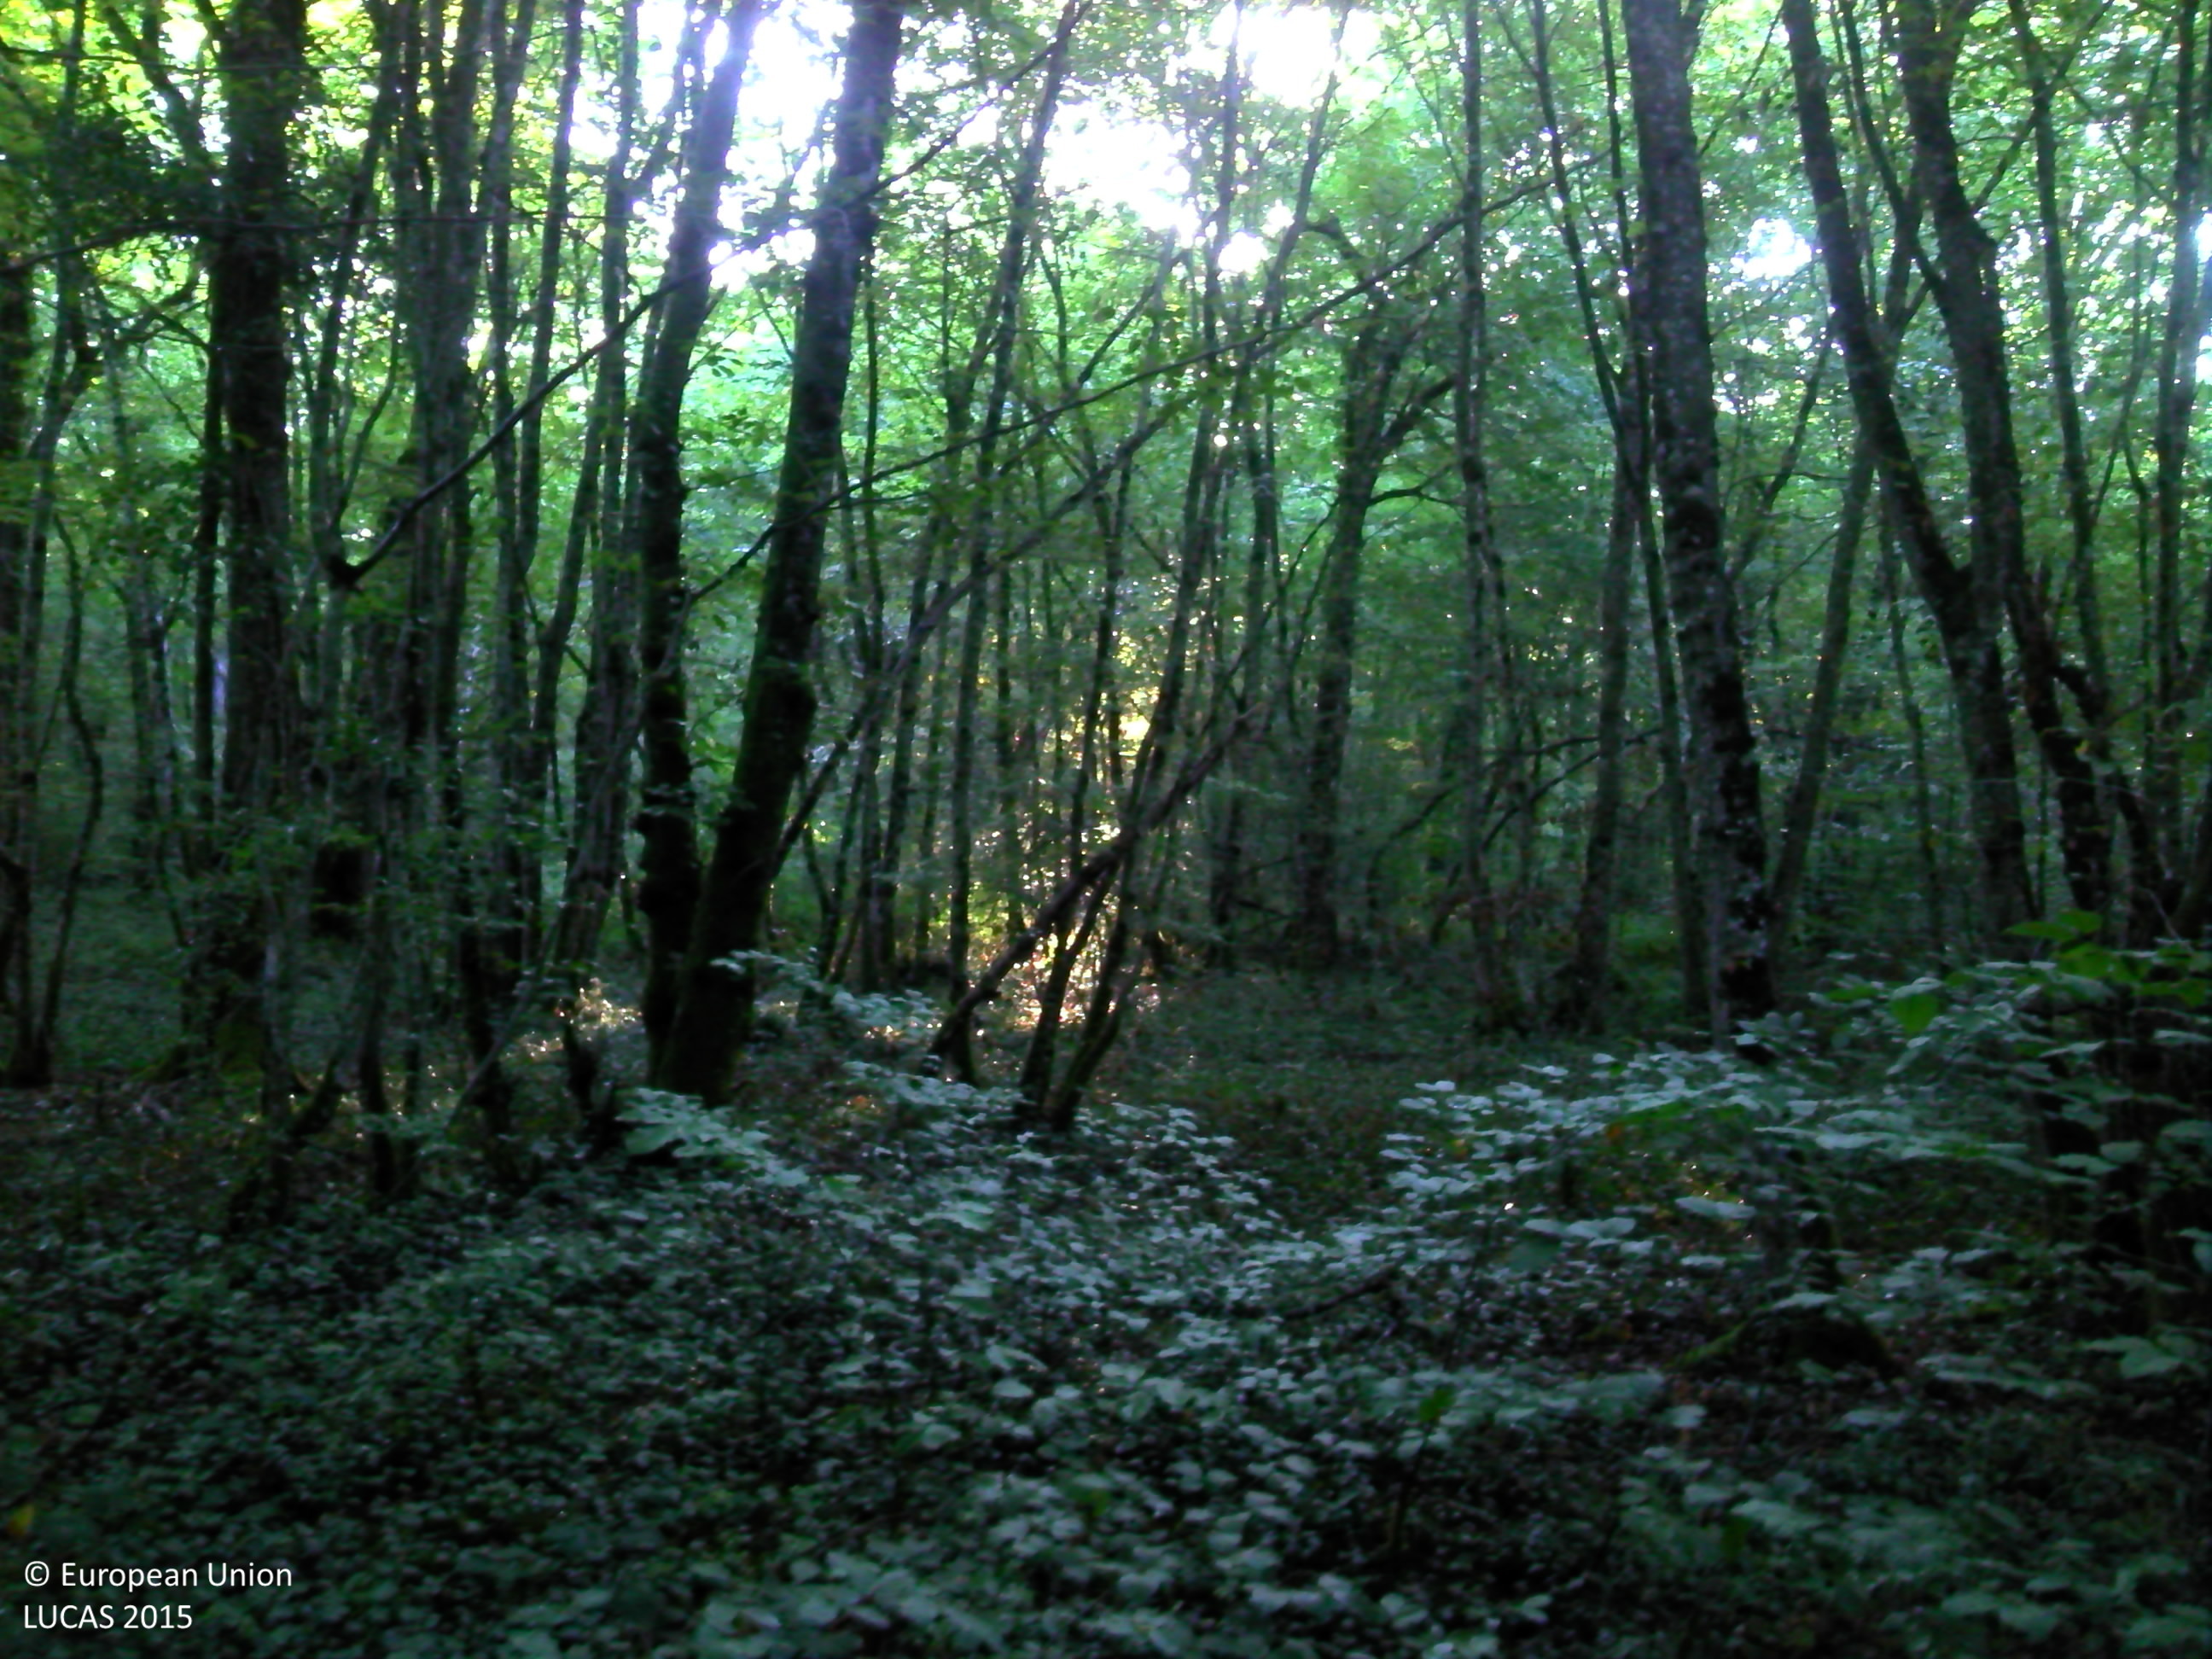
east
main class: Woodland
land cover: Broadleaved woodland
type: mesophytic deciduous forest
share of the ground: > 75 %
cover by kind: broadleaved forest trees 85 %, herbaceous plants 10 %, lichens and mosses 5 %
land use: Forestry
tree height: > 5 m
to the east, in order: Broadleaved woodland
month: September
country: FR
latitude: 48.1381
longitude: 4.8248
